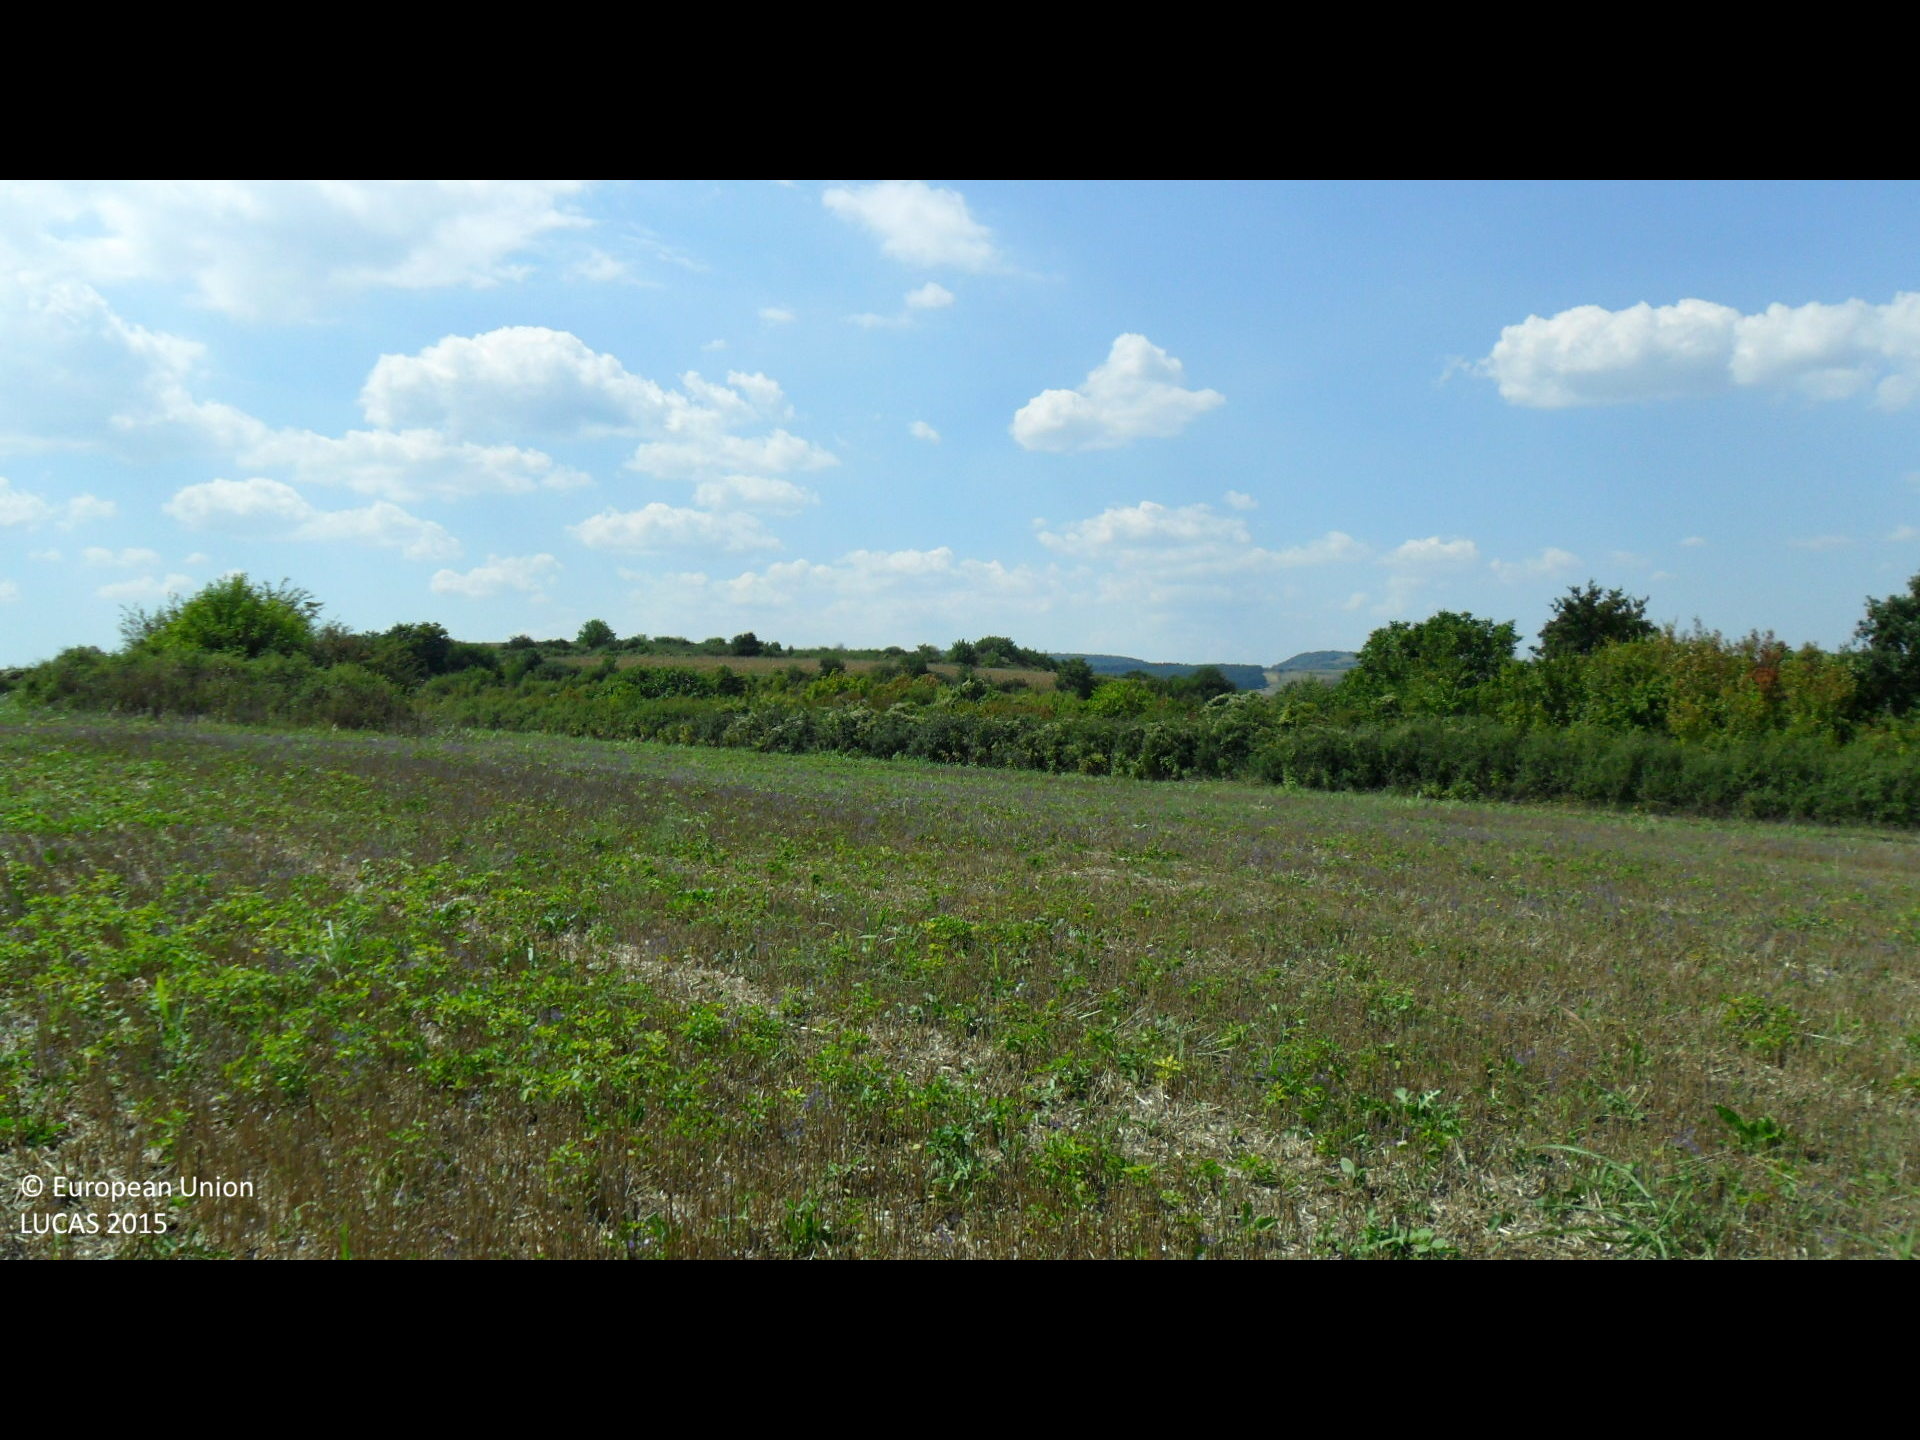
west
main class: Cropland
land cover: Barley
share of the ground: 50 - 75 %
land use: Agriculture (excluding fallow land and kitchen gardens)
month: August
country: BG
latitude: 43.4513
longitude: 26.3253
